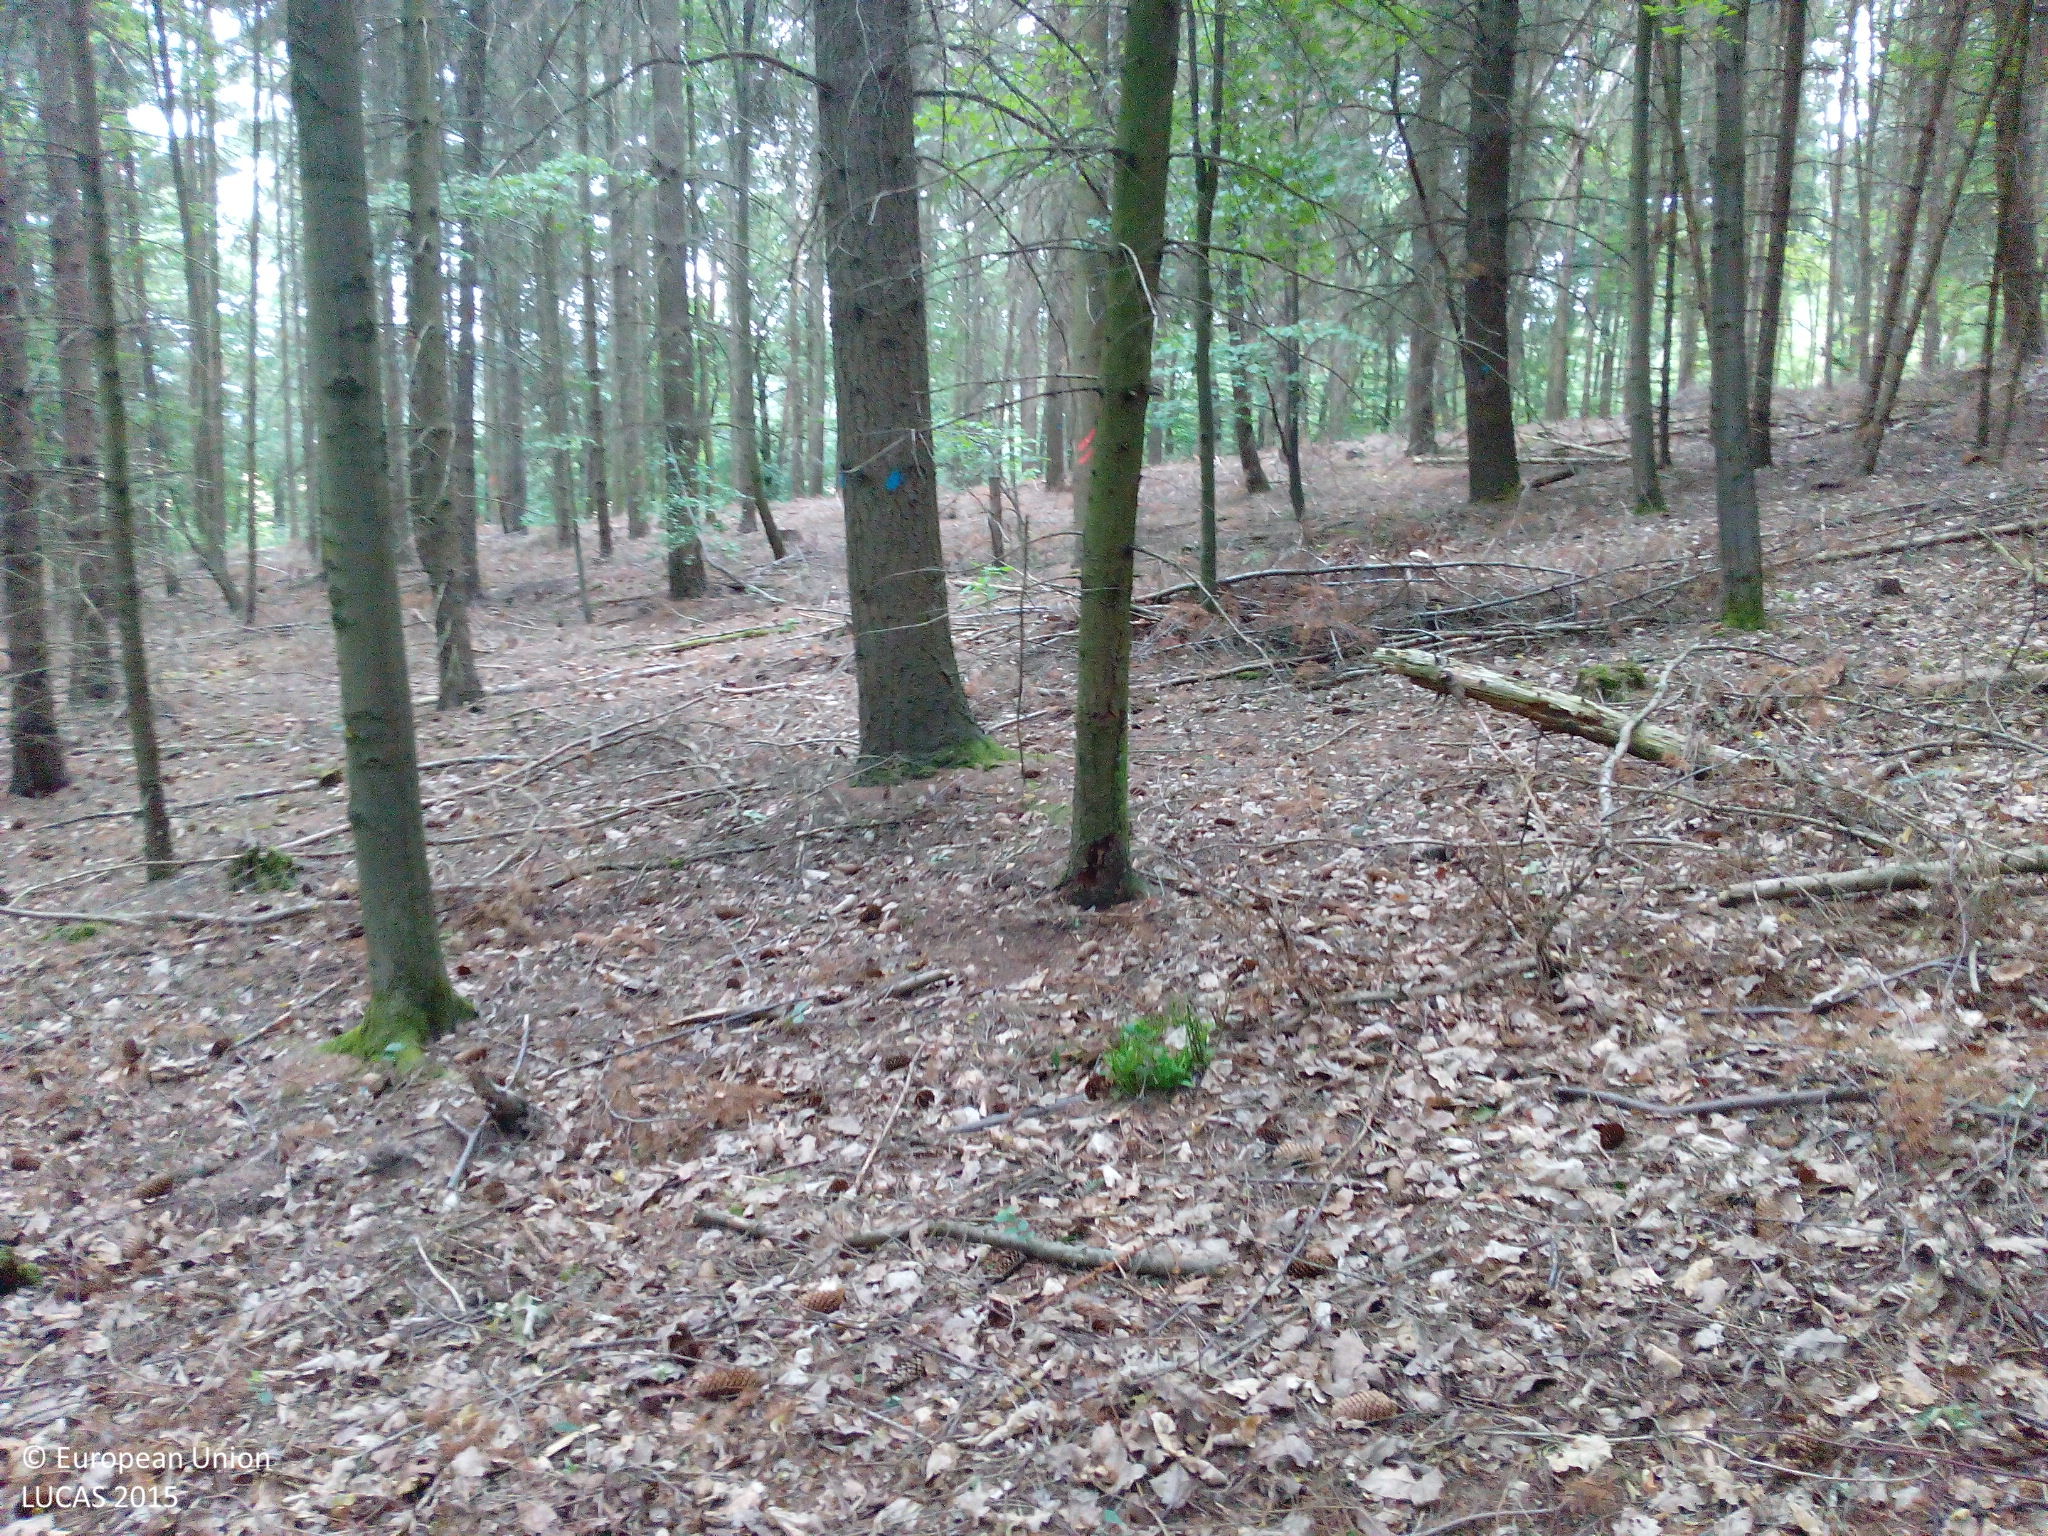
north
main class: Woodland
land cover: Spruce dominated mixed woodland
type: hemiboreal forest and nemoral coniferous forest and mixed broadleaved-coniferous forest
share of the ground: > 75 %
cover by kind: coniferous forest trees 45 %, broadleaved forest trees 45 %, unconsolidated bare surface 10 %
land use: Forestry
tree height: > 5 m
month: July
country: DE
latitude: 49.5893
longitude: 10.5670
